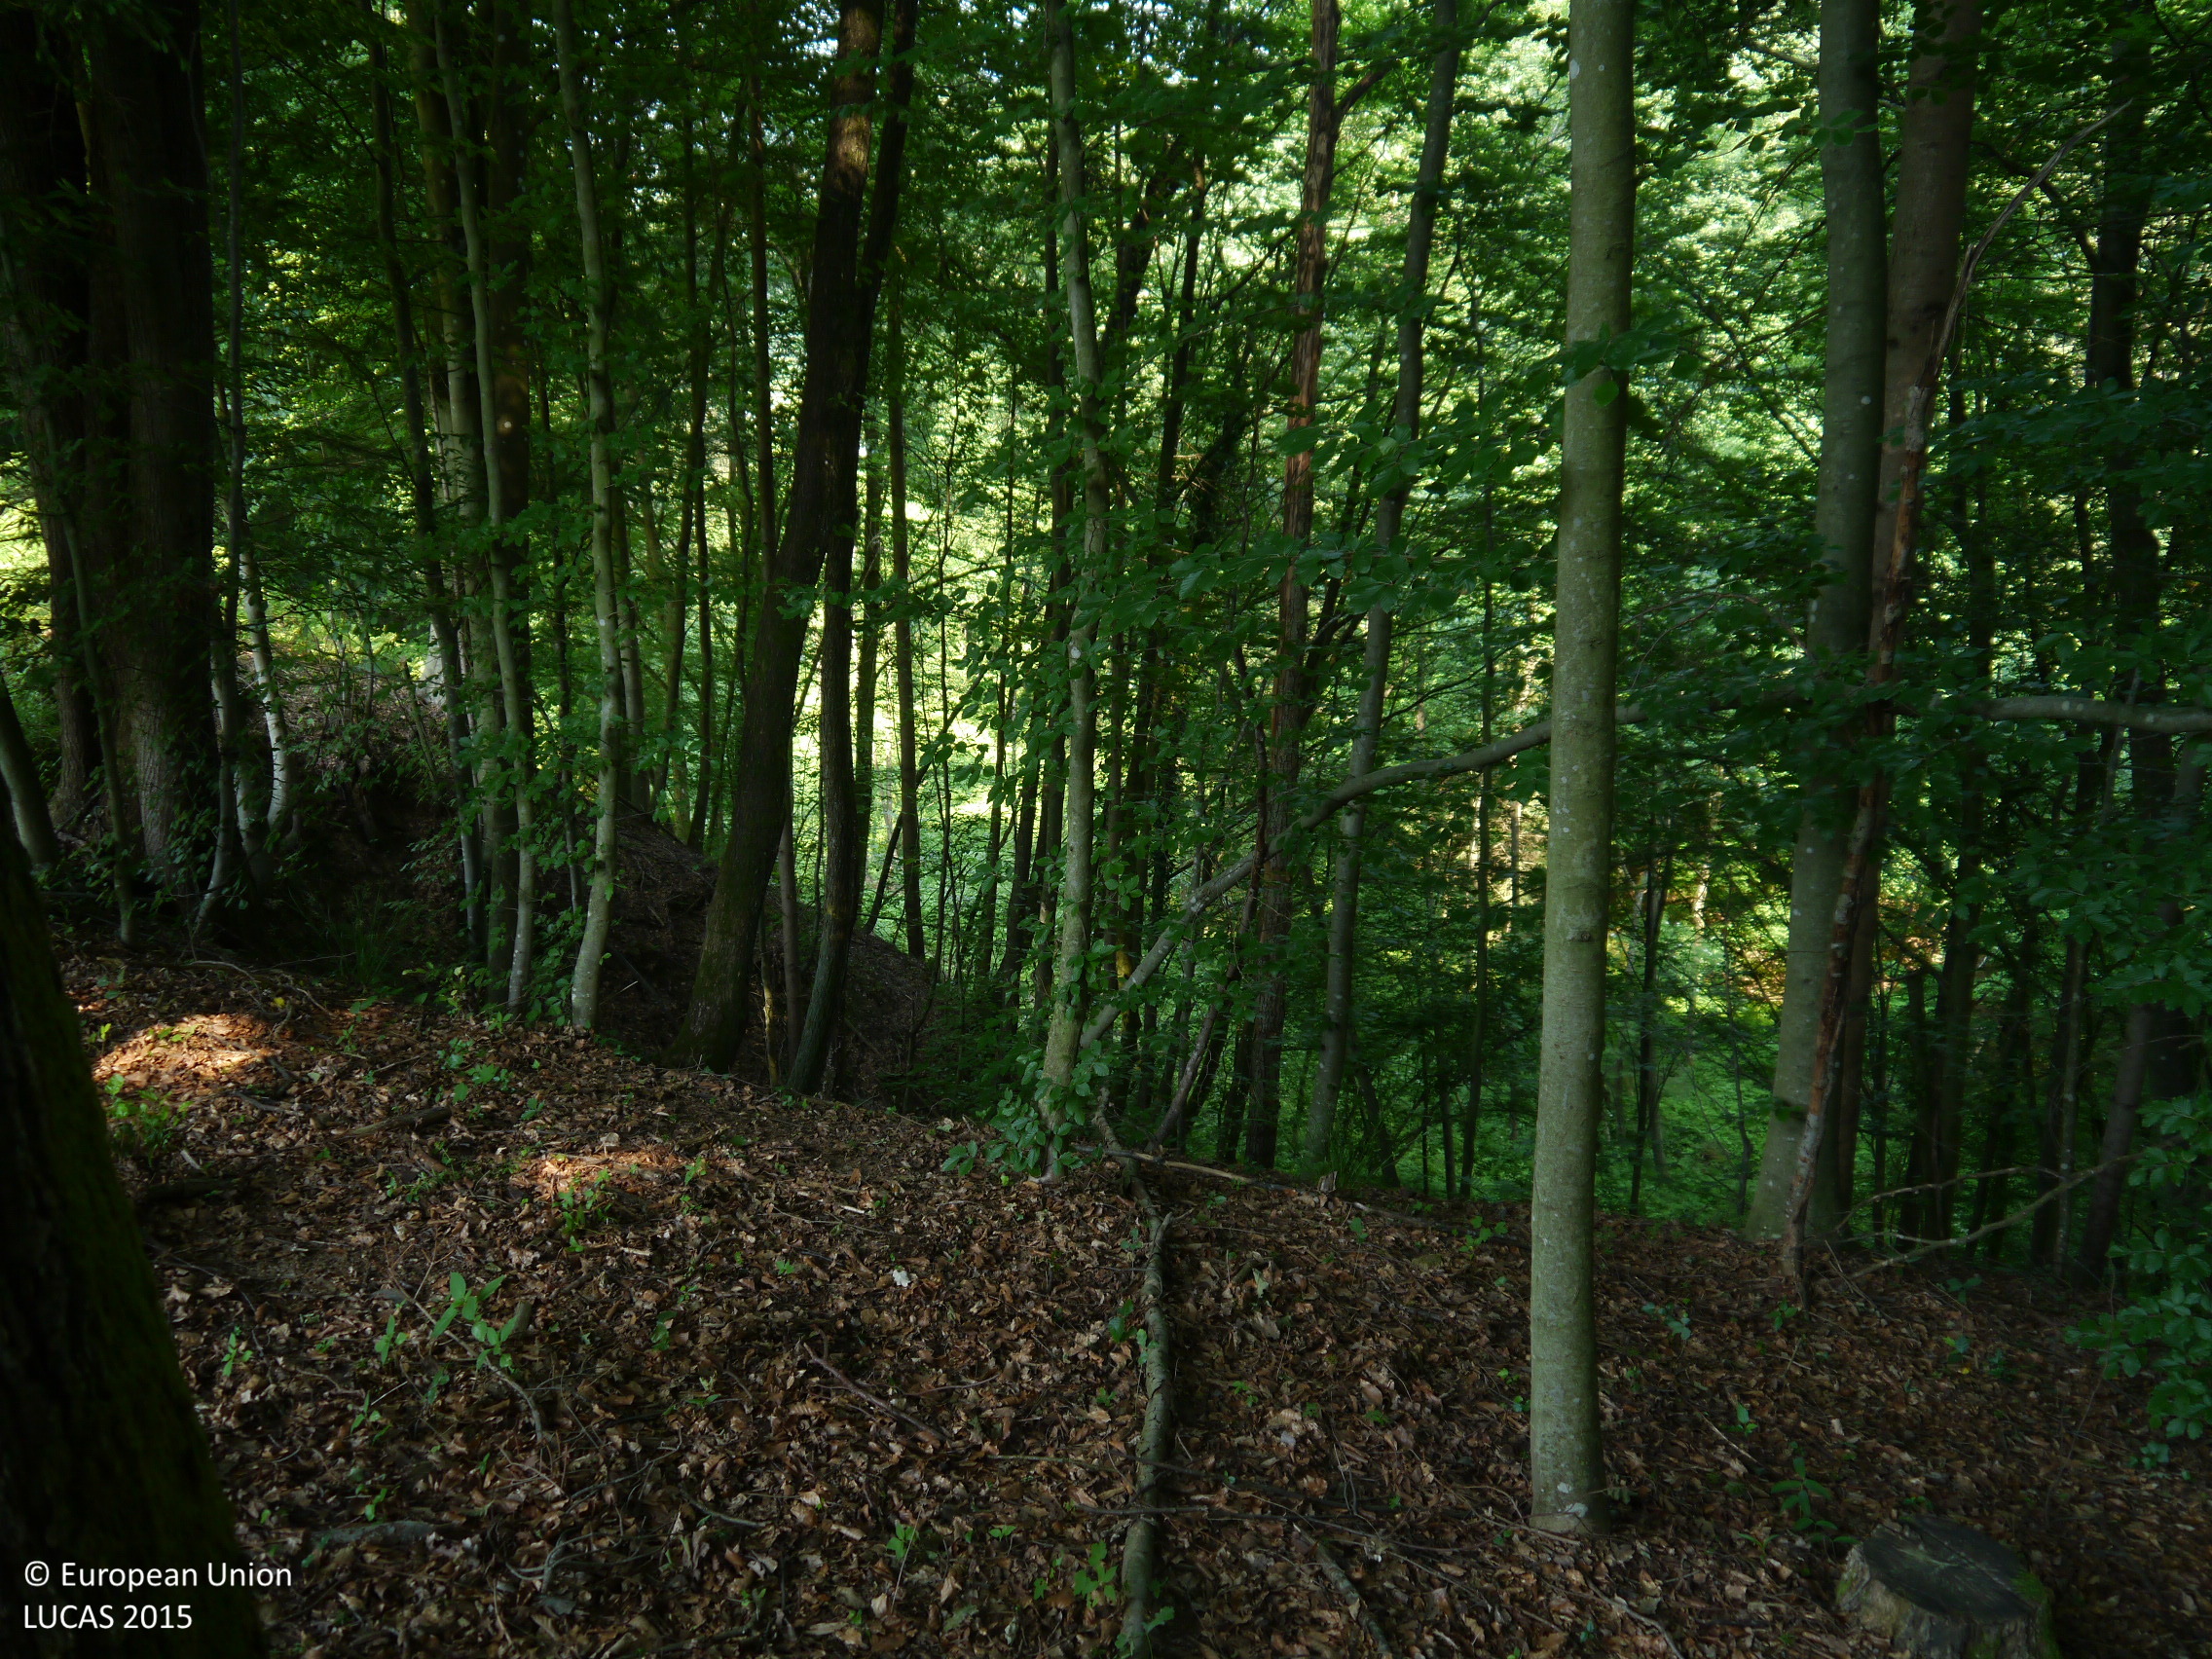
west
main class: Woodland
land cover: Broadleaved woodland
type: mountainous beech forest
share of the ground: > 75 %
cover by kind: broadleaved forest trees 90 %, coniferous forest trees 10 %
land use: Forestry
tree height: > 5 m
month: June
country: AT
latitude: 46.7817
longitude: 15.2512
